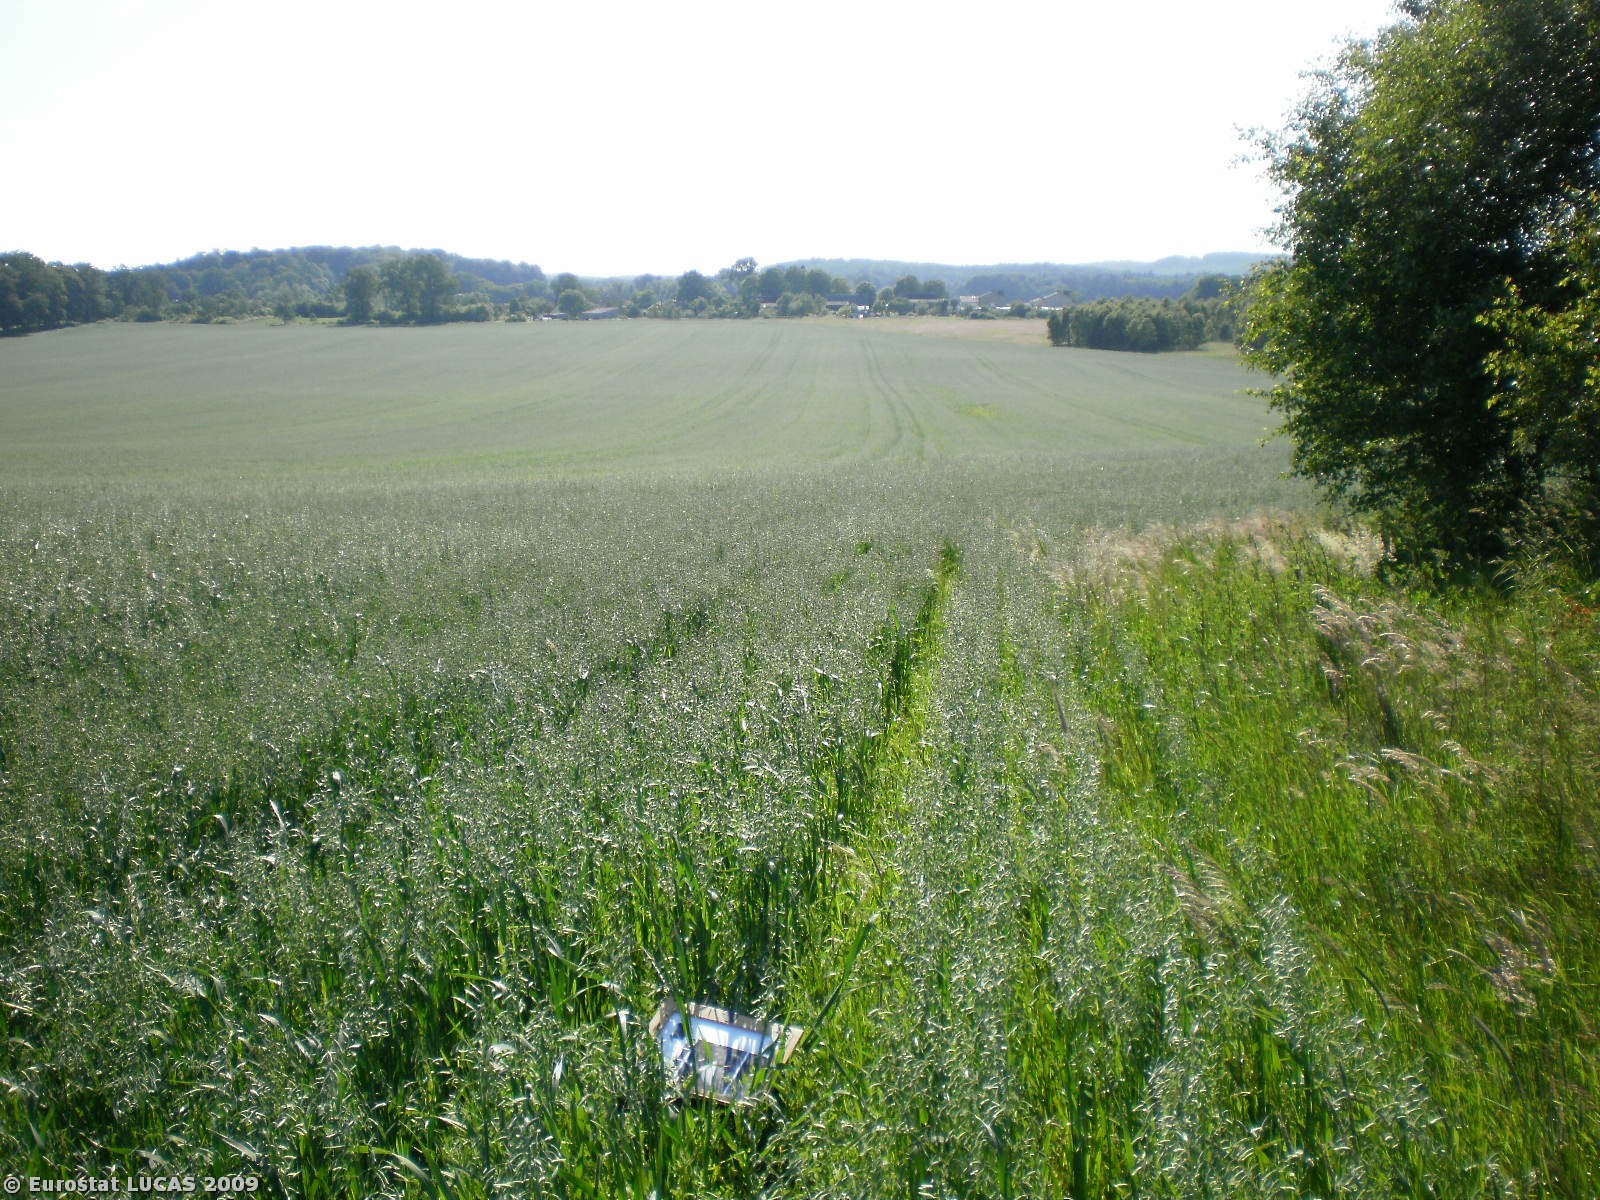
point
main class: Cropland
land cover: Oats
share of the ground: > 75 %
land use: Agriculture (excluding fallow land and kitchen gardens)
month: June
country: PL
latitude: 54.6236
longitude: 17.3353
